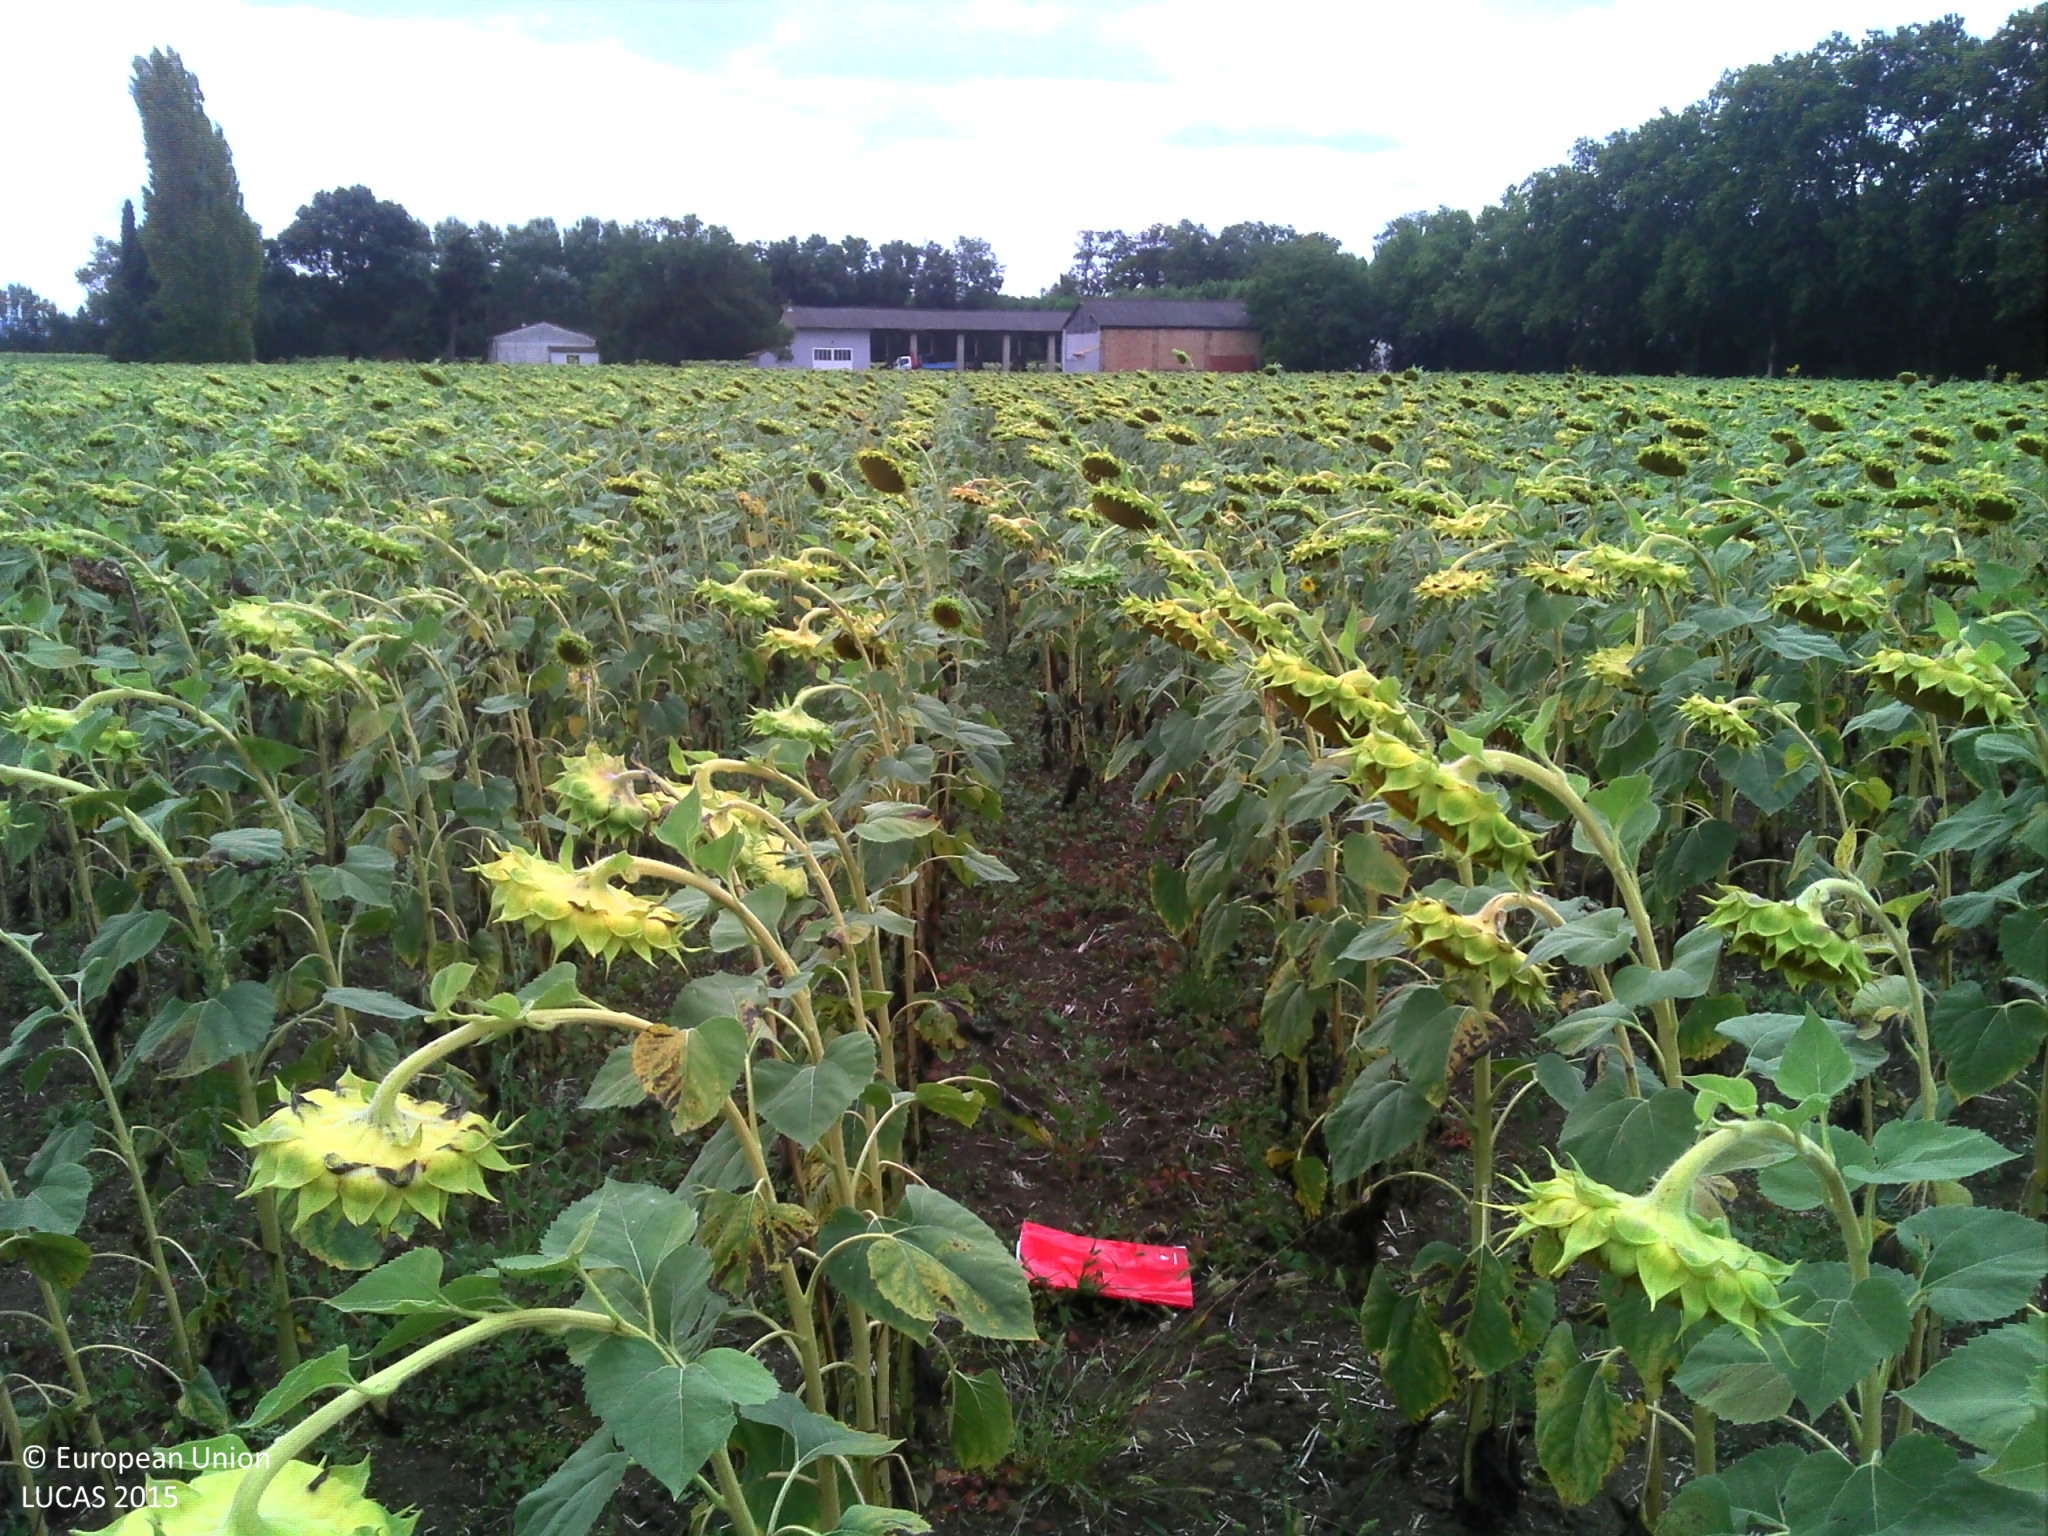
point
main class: Cropland
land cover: Sunflower
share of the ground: 50 - 75 %
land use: Agriculture (excluding fallow land and kitchen gardens)
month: June
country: FR
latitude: 43.2828
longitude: 2.0335
